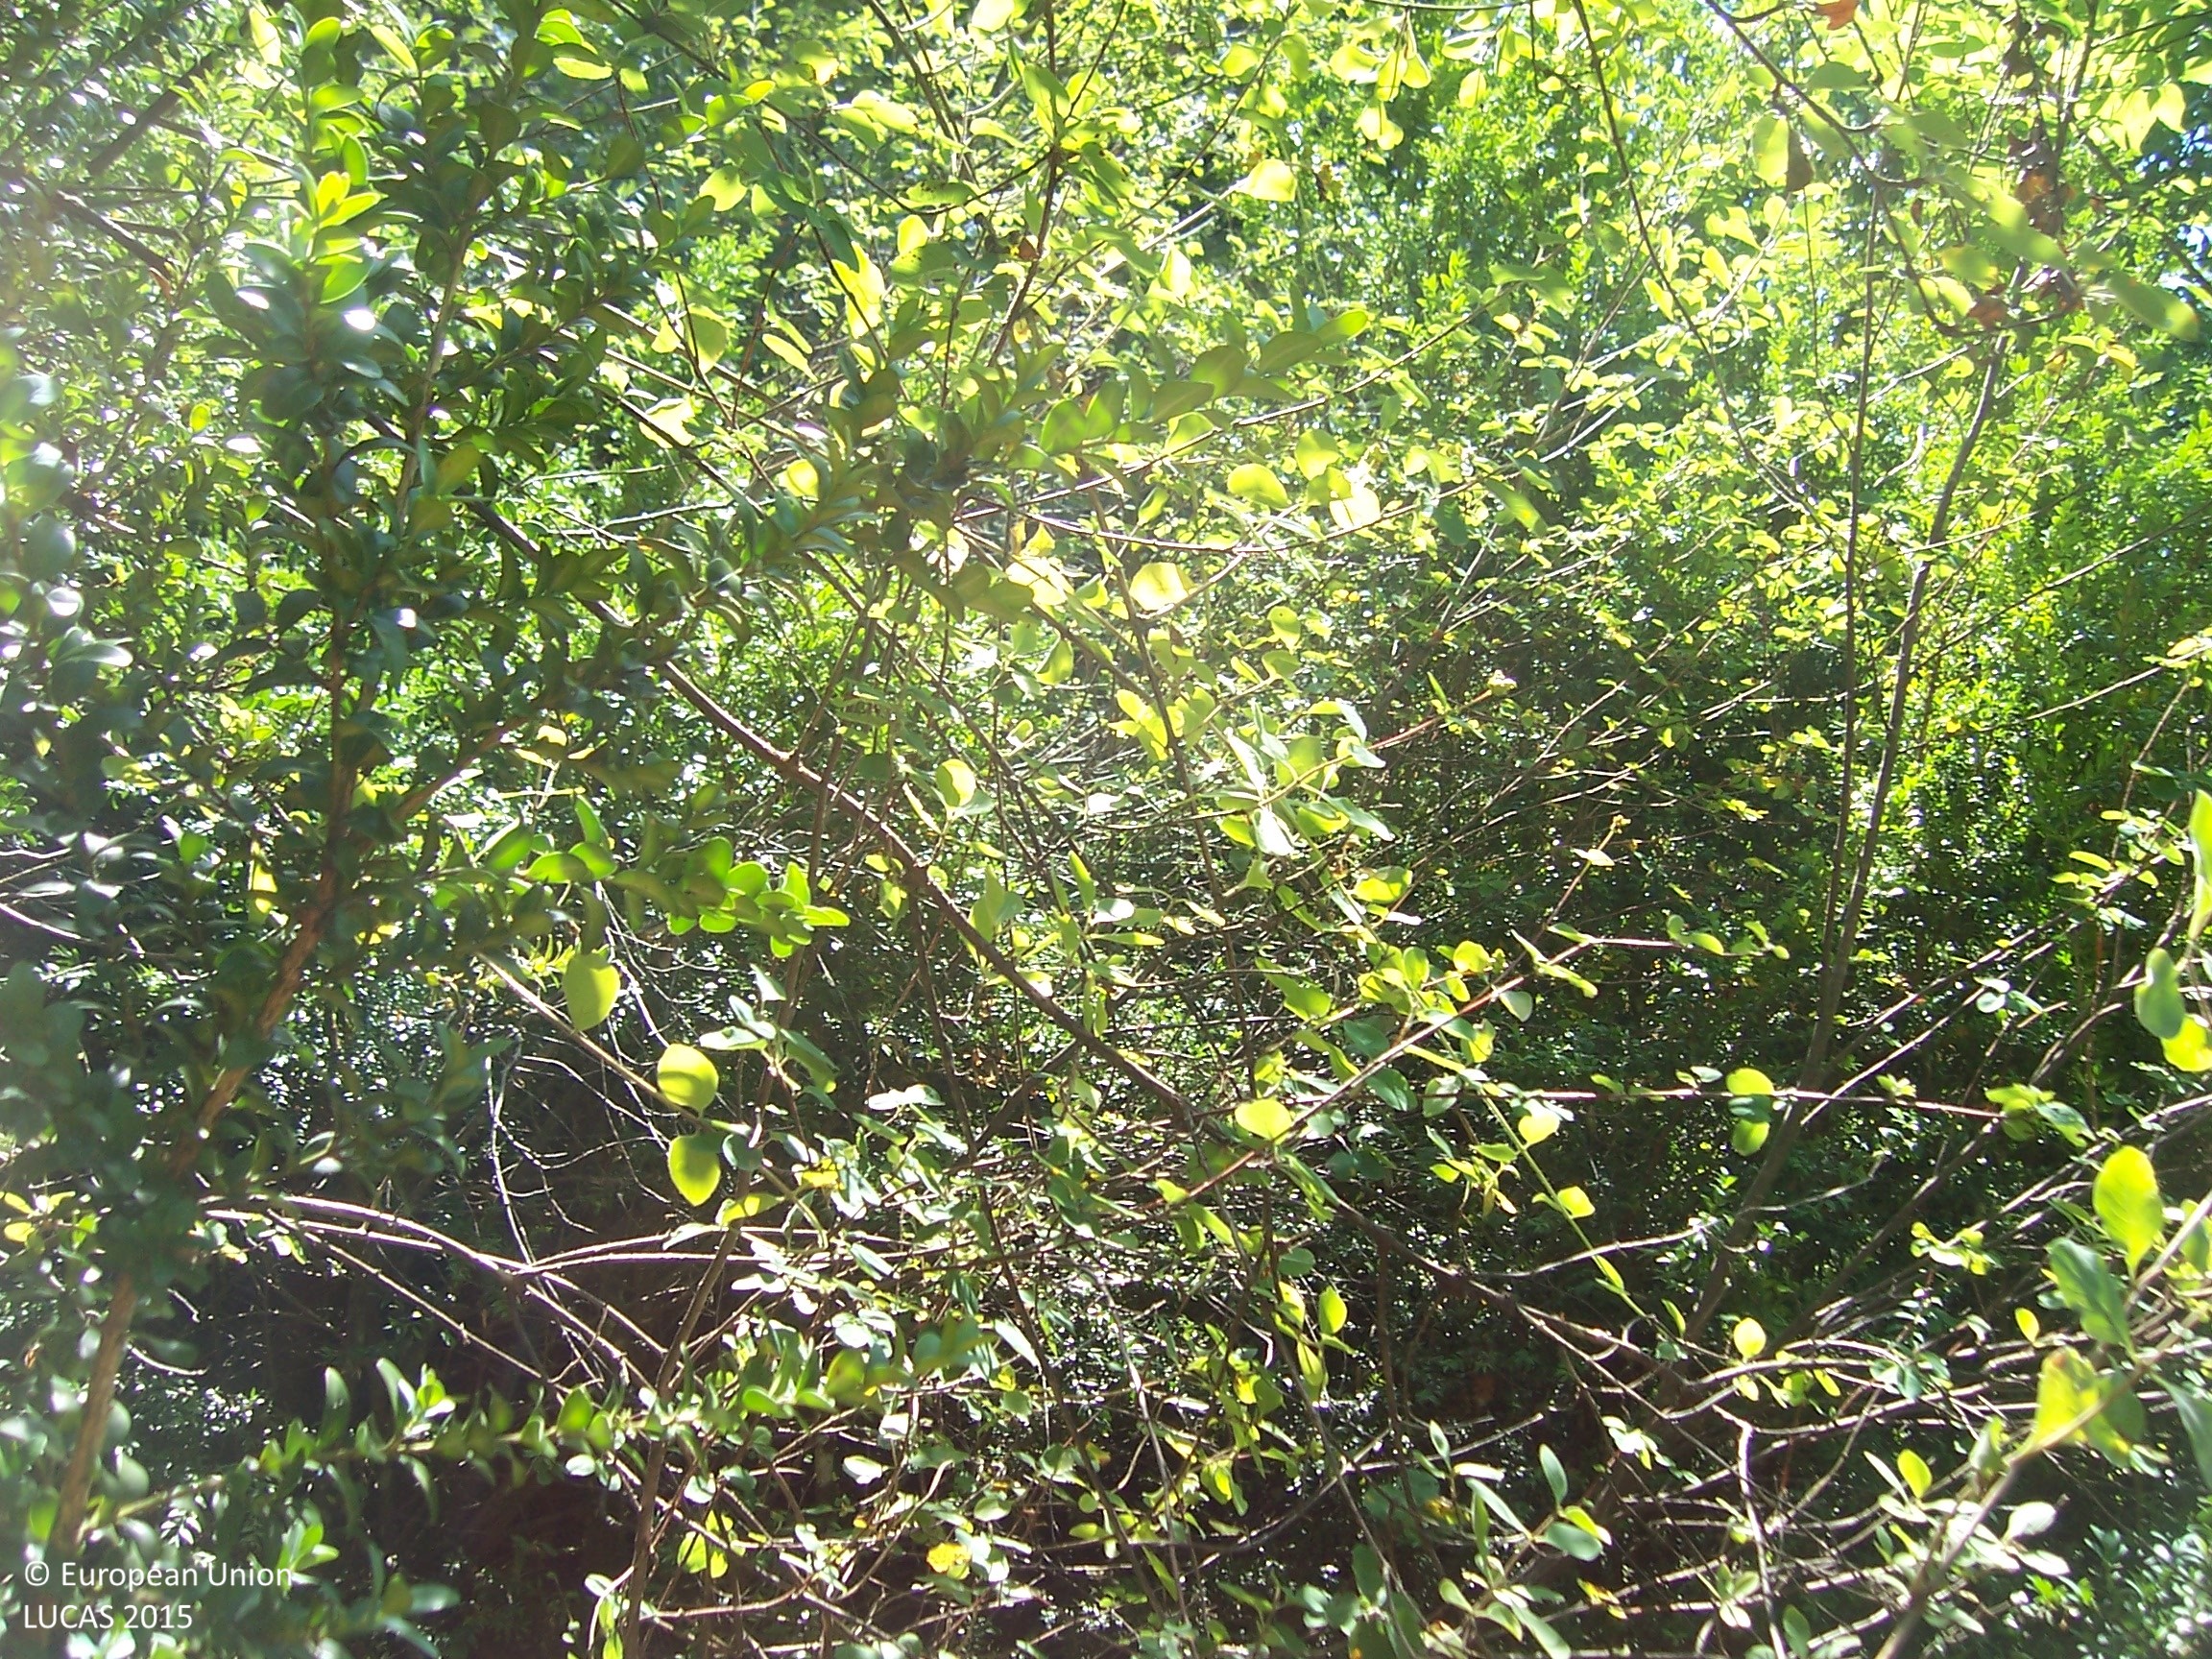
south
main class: Woodland
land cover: Broadleaved woodland
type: mountainous beech forest
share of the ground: > 75 %
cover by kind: broadleaved forest trees 100 %
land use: Semi-natural and natural areas not in use
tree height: > 5 m
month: August
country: ES
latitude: 42.6200
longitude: -0.1070
